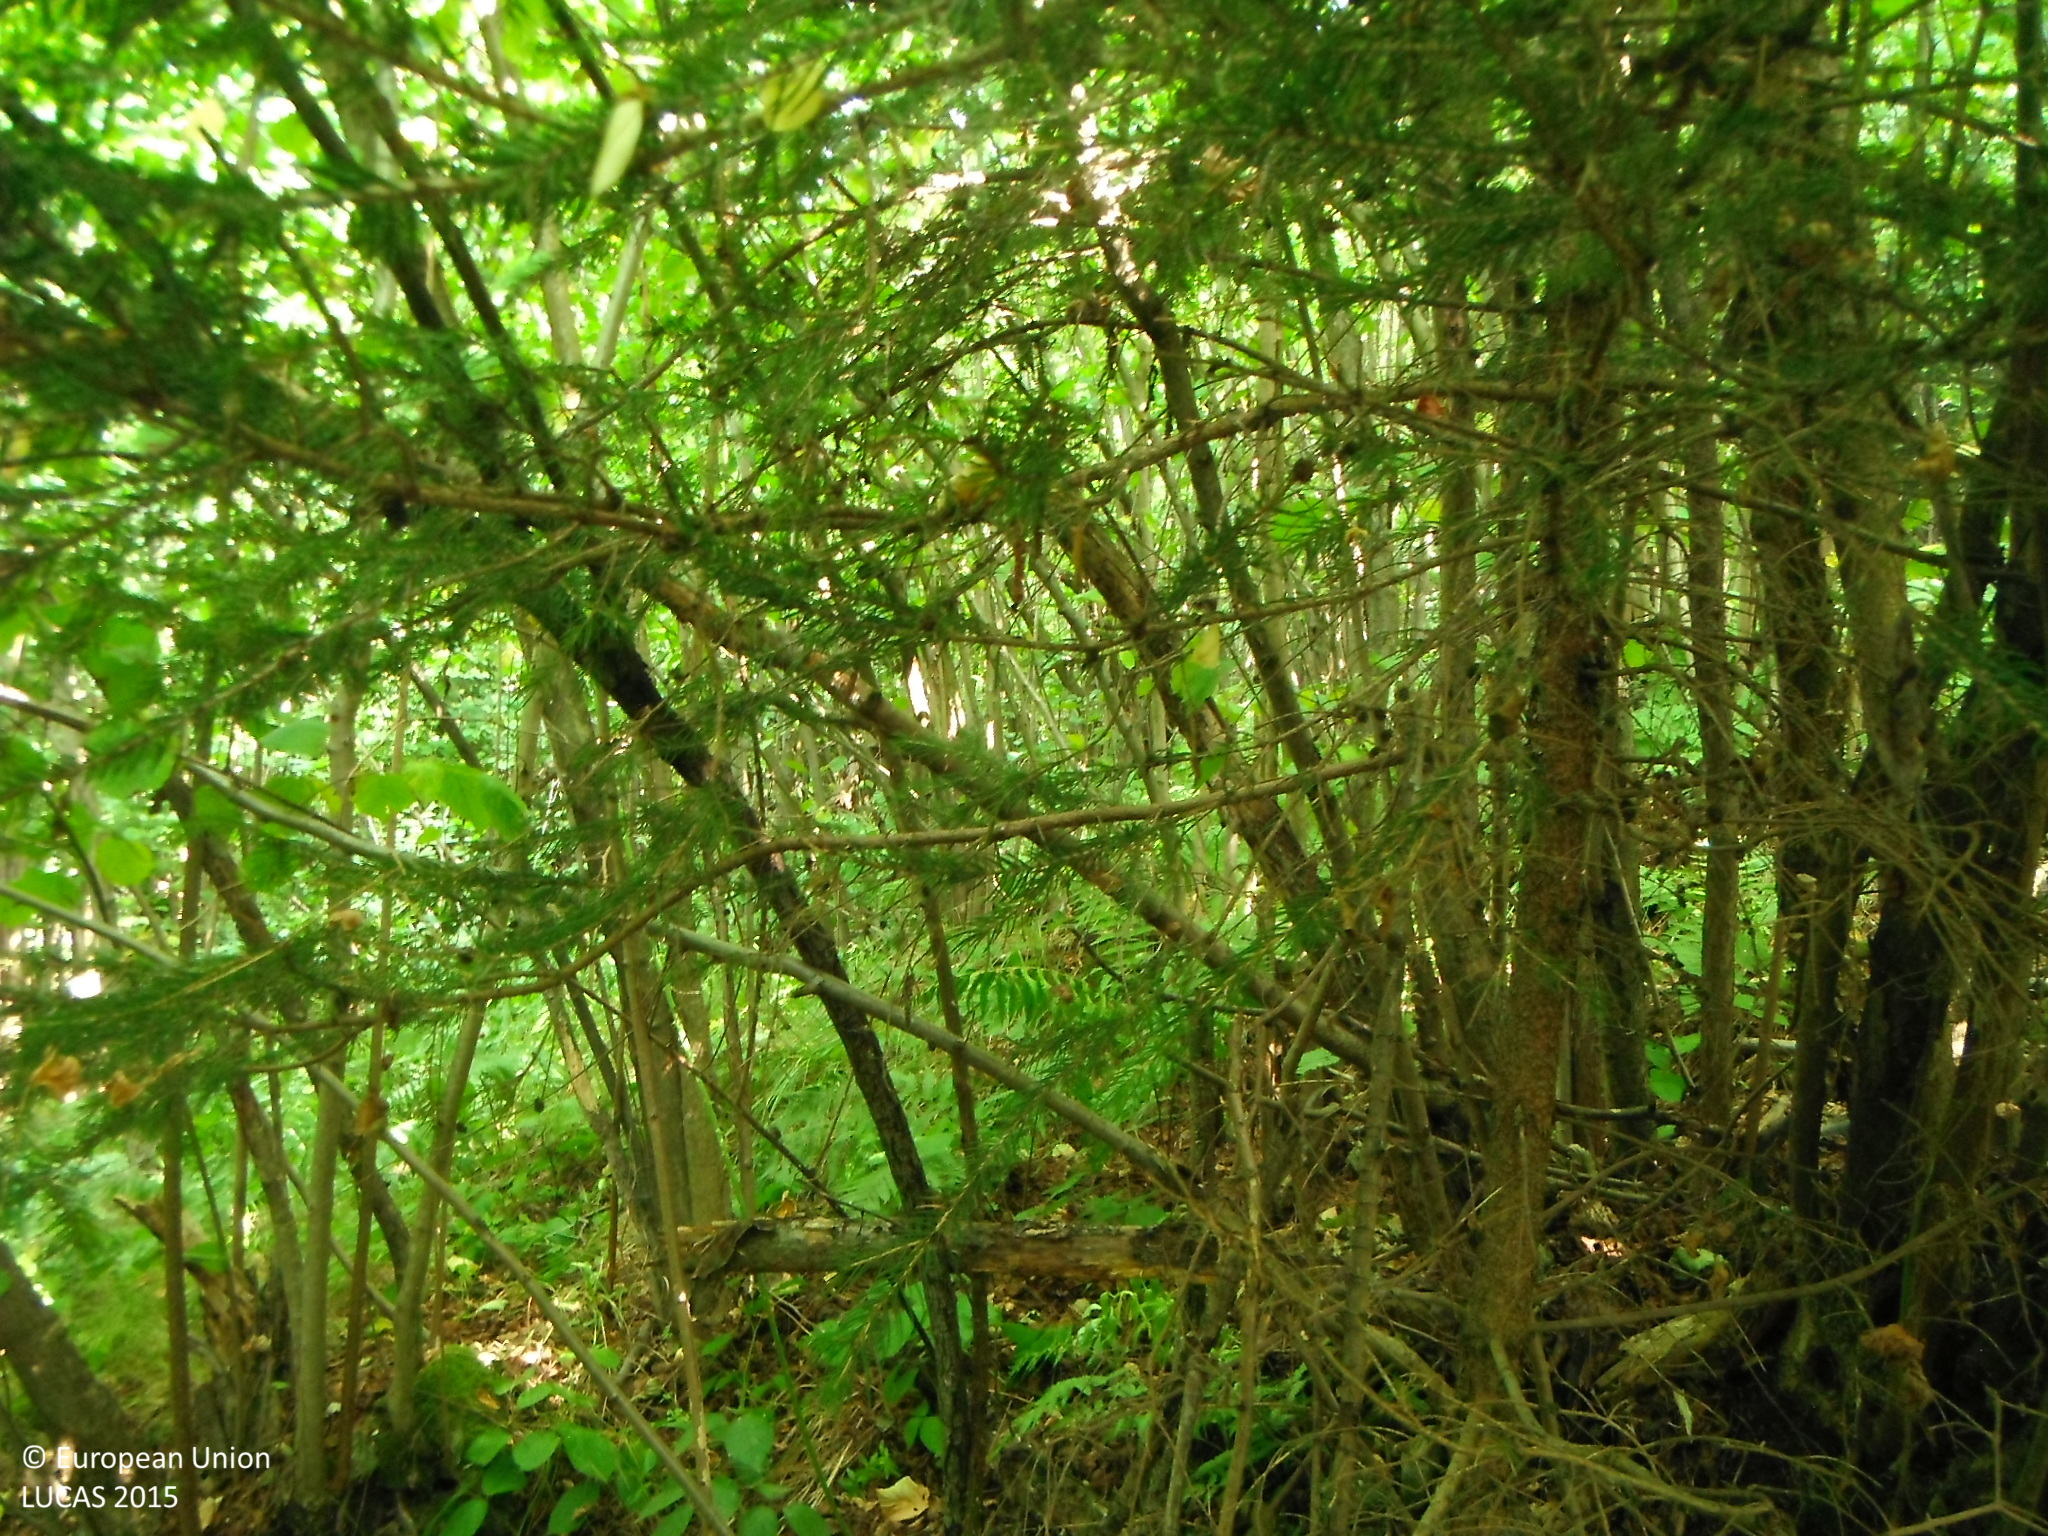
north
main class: Woodland
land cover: Other mixed woodland
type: hemiboreal forest and nemoral coniferous forest and mixed broadleaved-coniferous forest
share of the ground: > 75 %
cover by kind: broadleaved forest trees 60 %, coniferous forest trees 40 %
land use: Semi-natural and natural areas not in use
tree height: > 5 m
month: August
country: SK
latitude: 48.8681
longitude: 19.8583
